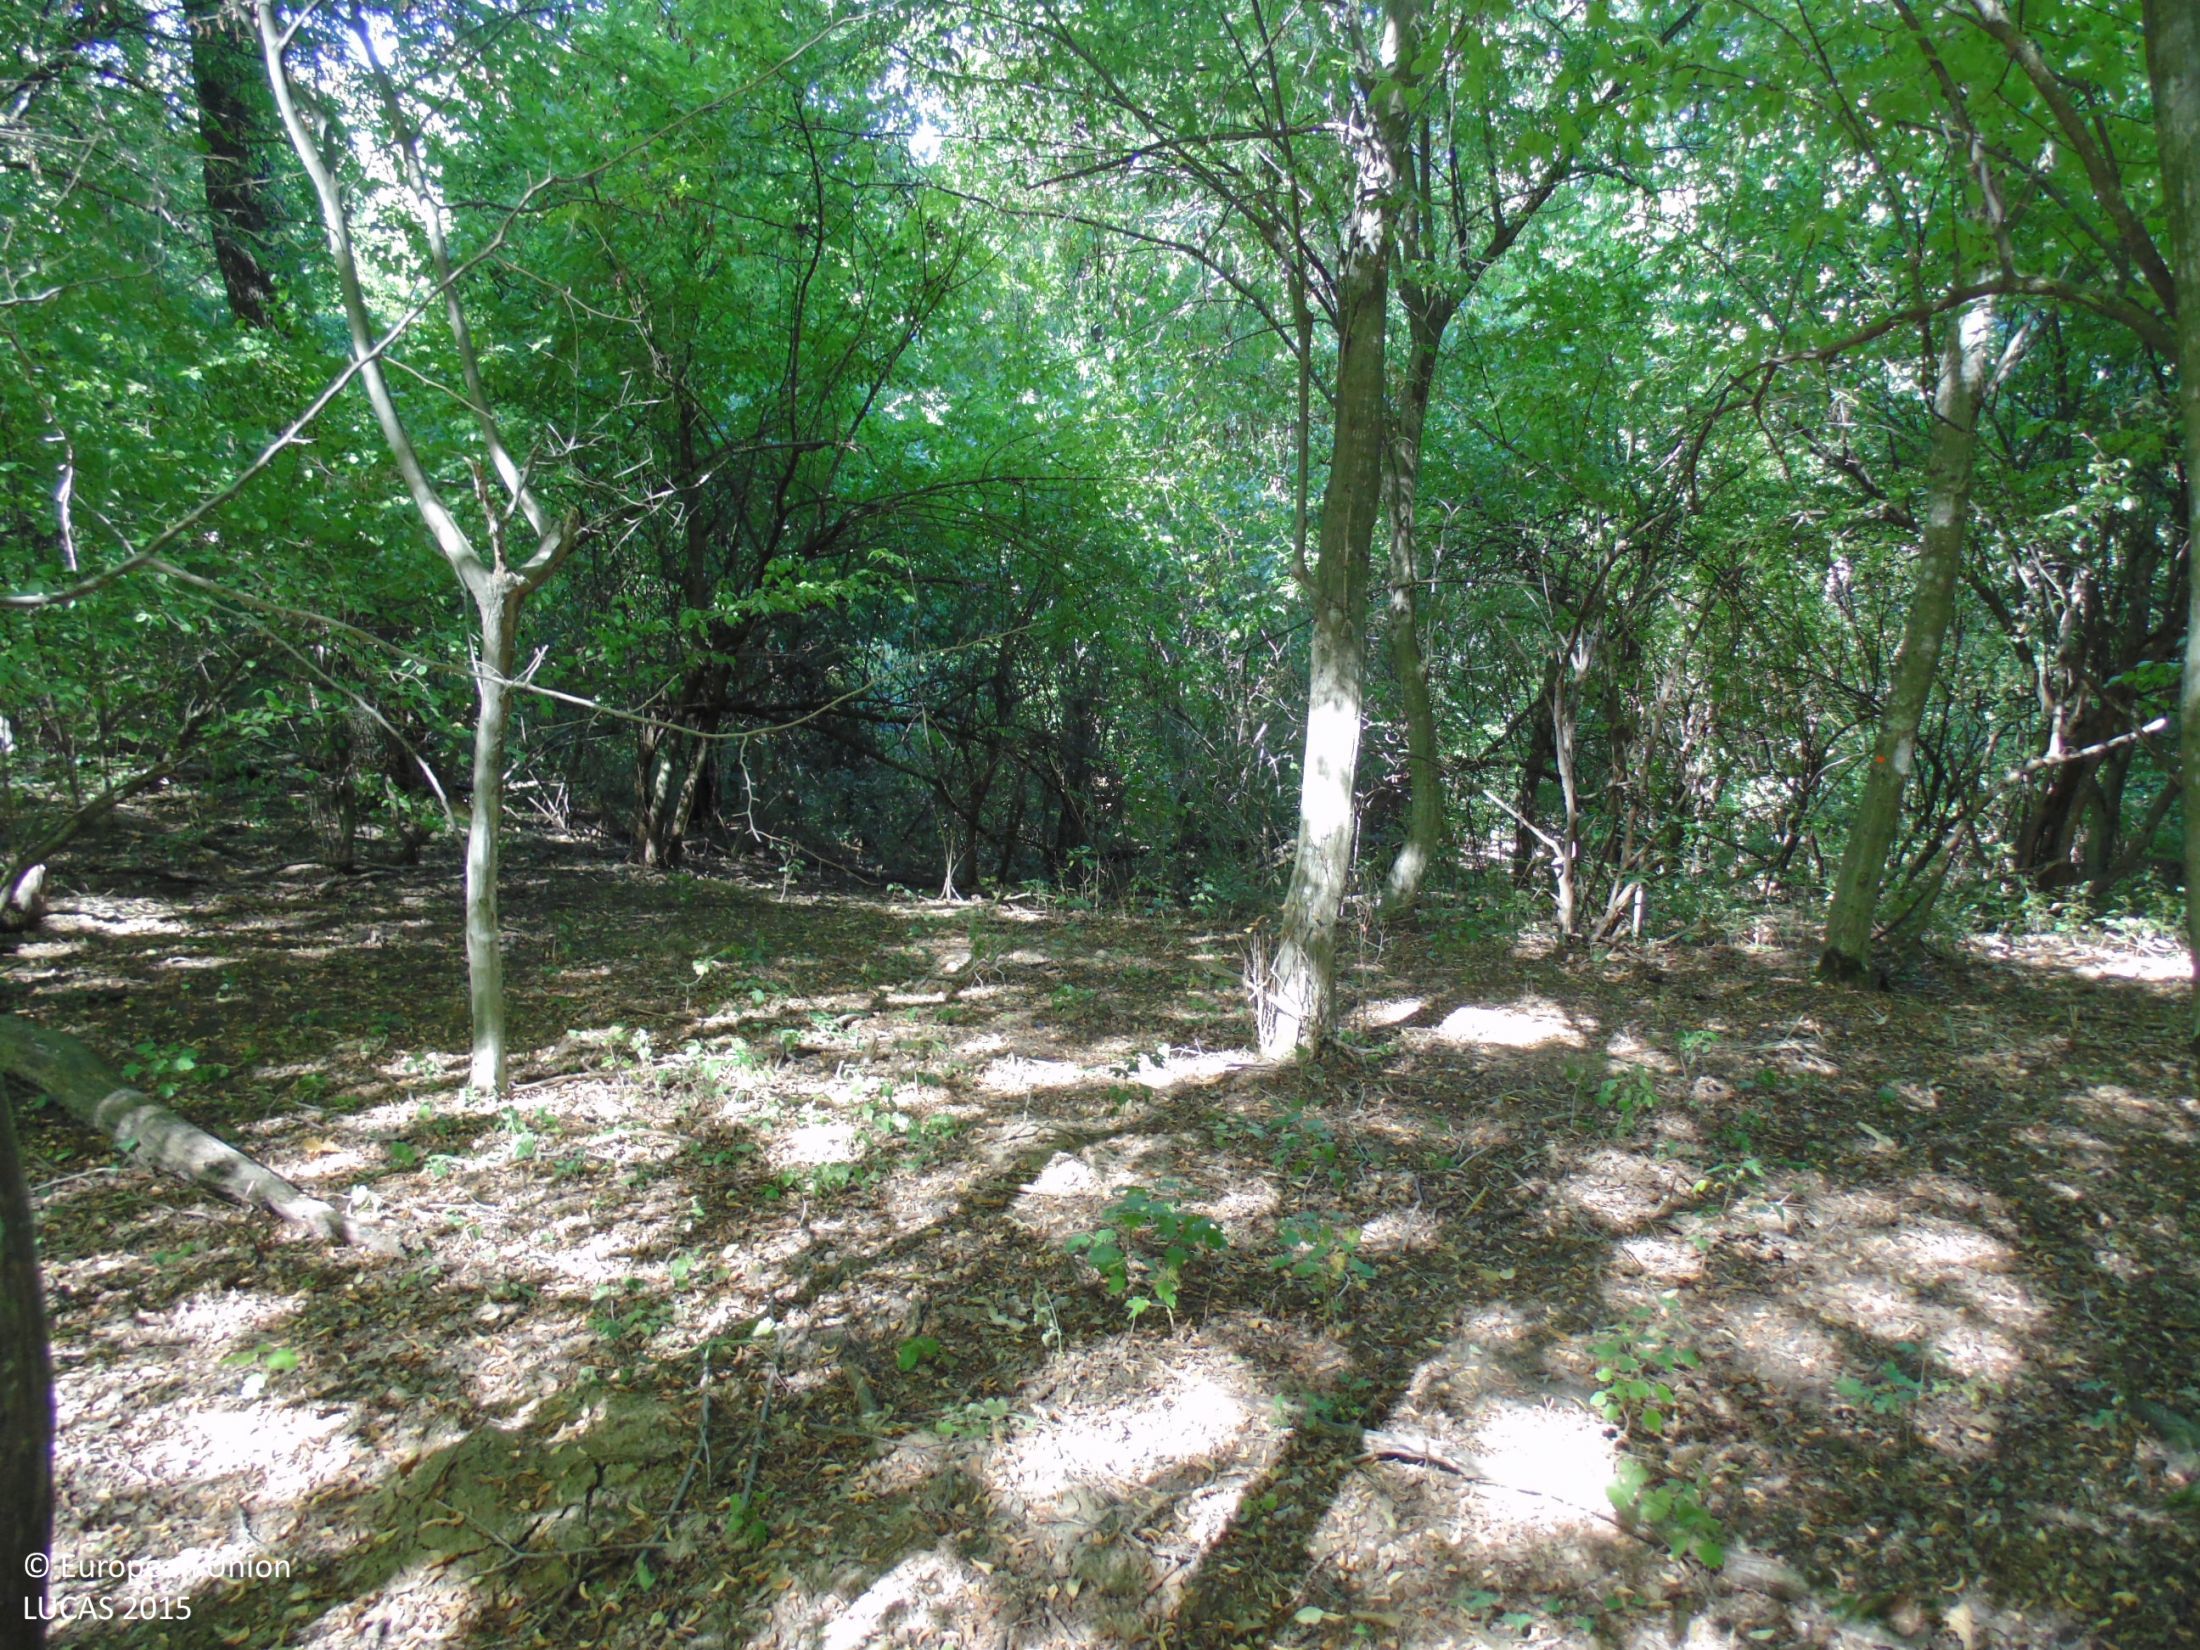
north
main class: Woodland
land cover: Broadleaved woodland
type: mesophytic deciduous forest
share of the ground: > 75 %
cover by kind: broadleaved forest trees 95 %, unconsolidated bare surface 5 %
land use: Forestry
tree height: > 5 m
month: September
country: BG
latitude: 43.8682
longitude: 27.0332
